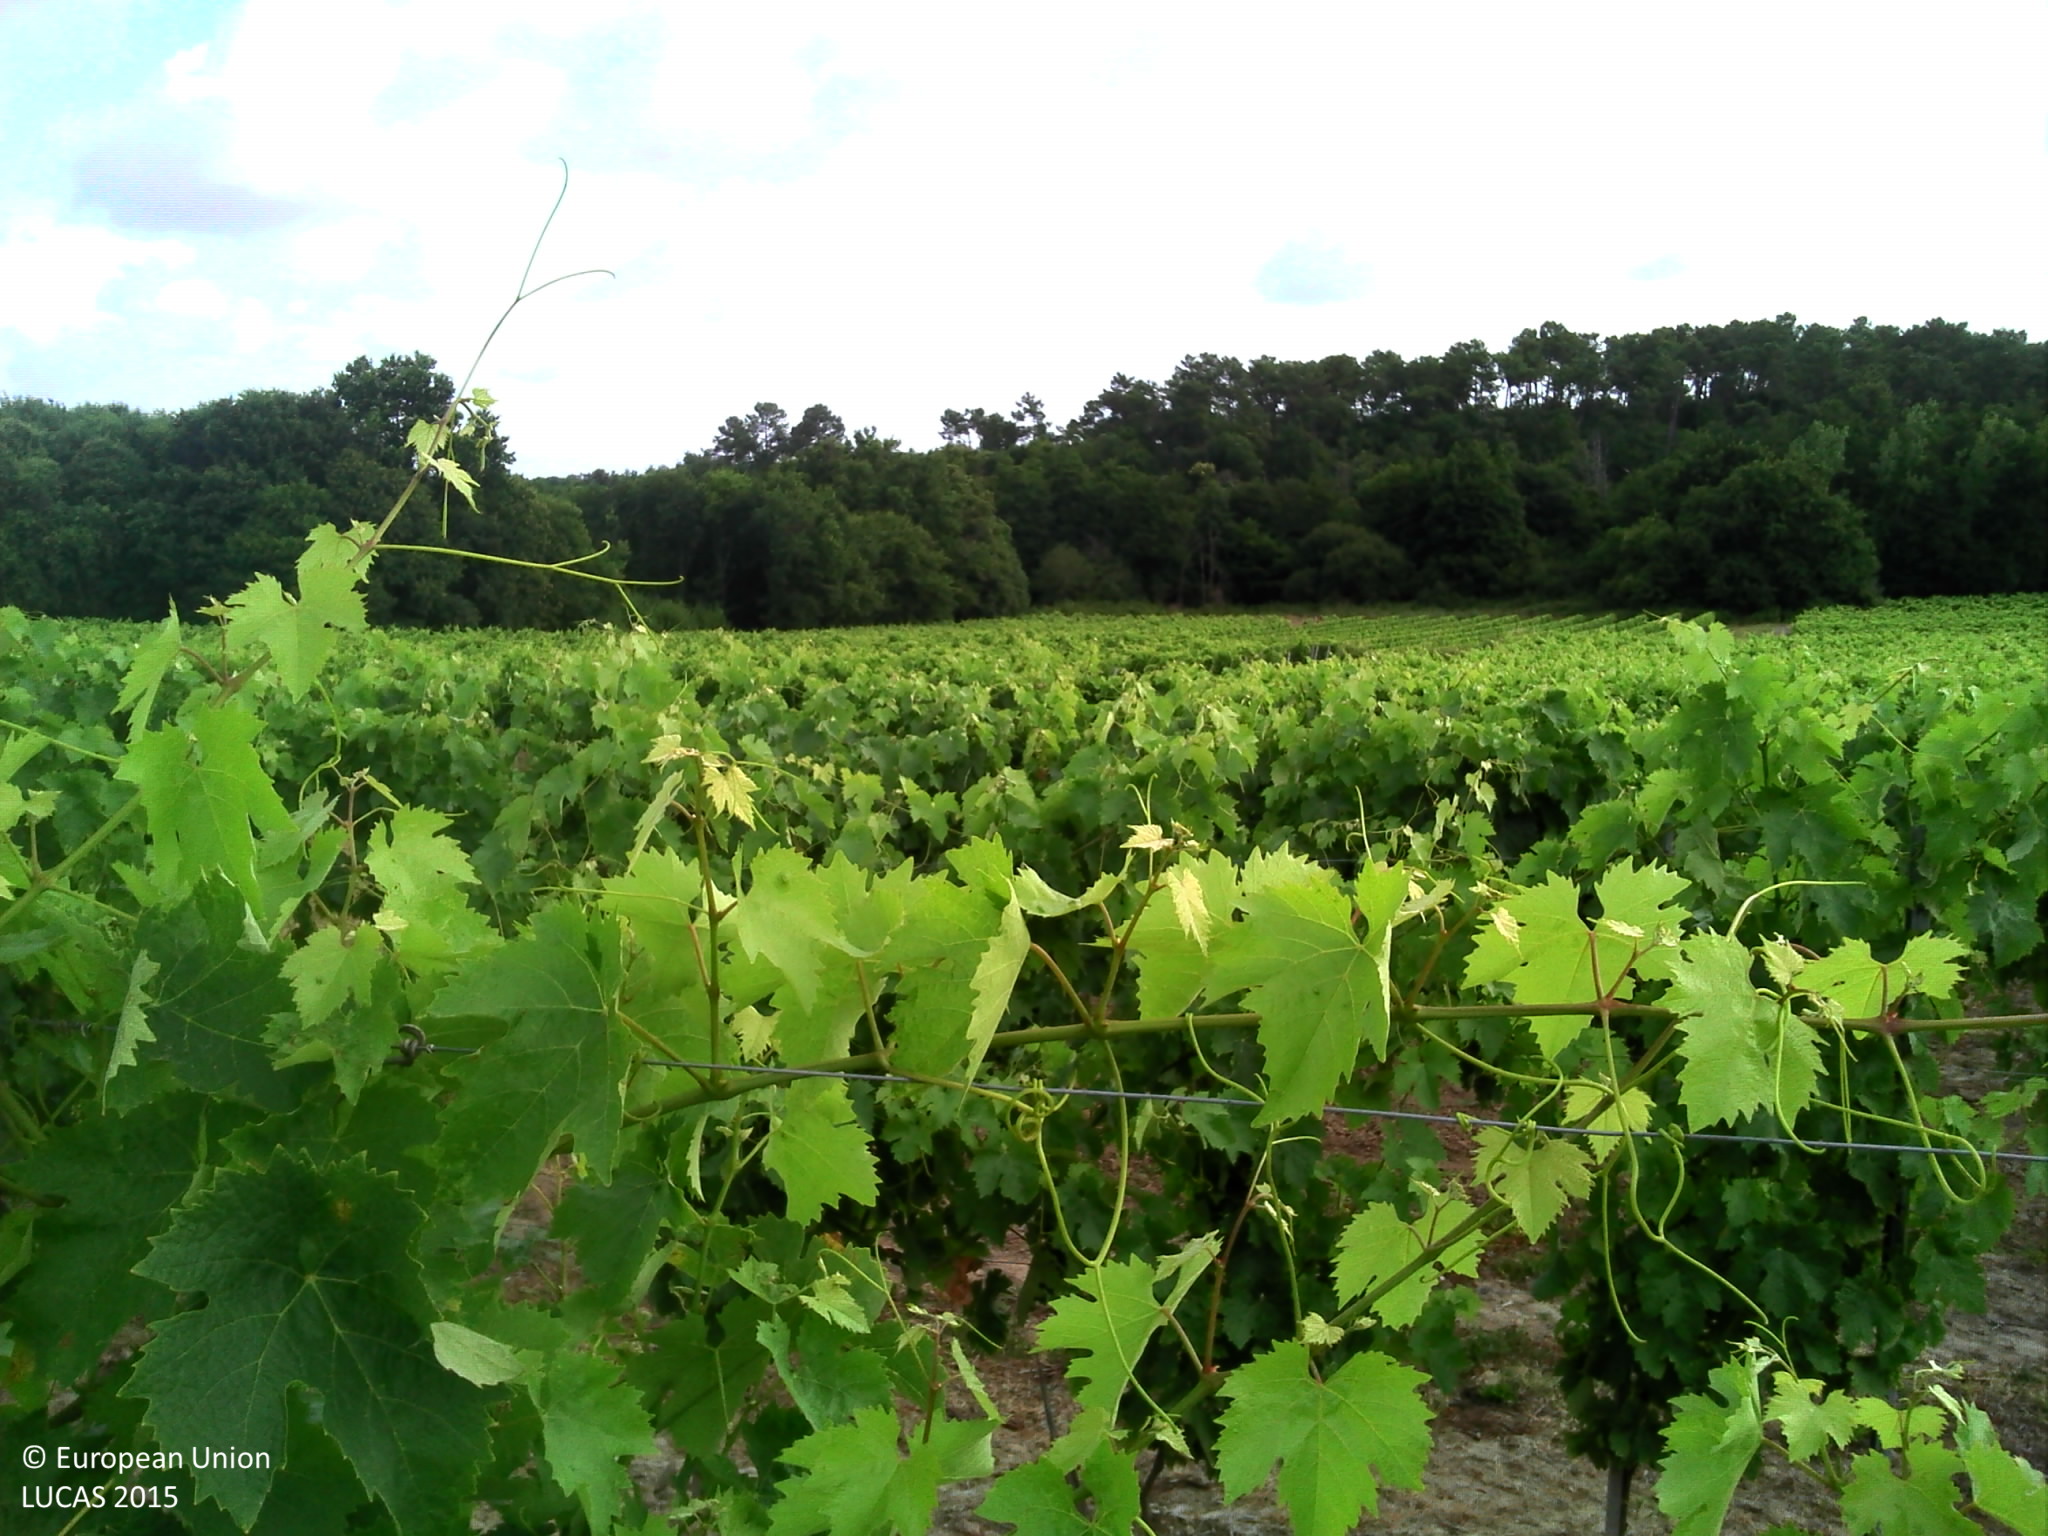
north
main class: Cropland
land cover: Vineyards
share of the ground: 50 - 75 %
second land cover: Other bare soil
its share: > 75 %
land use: Agriculture (excluding fallow land and kitchen gardens)
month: July
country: FR
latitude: 45.3301
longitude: -0.6248
